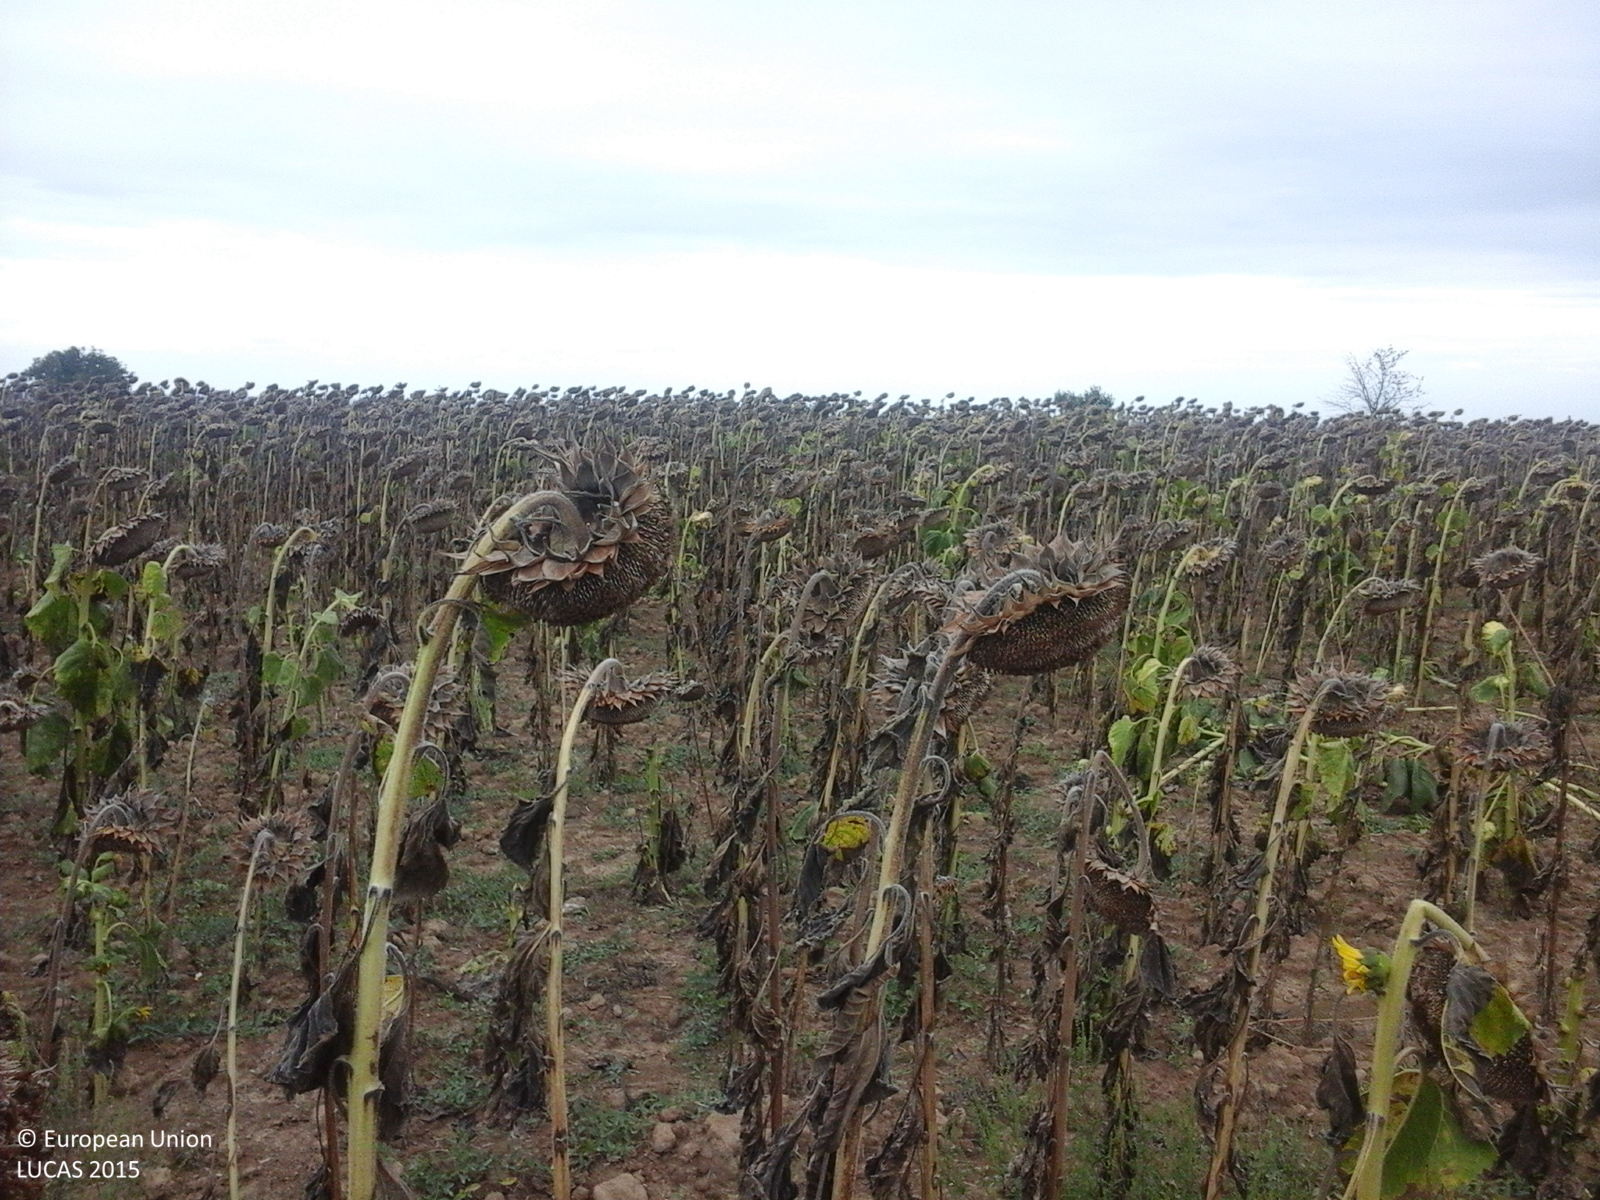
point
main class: Cropland
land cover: Sunflower
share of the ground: > 75 %
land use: Agriculture (excluding fallow land and kitchen gardens)
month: September
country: RO
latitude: 47.4412
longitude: 22.4545
